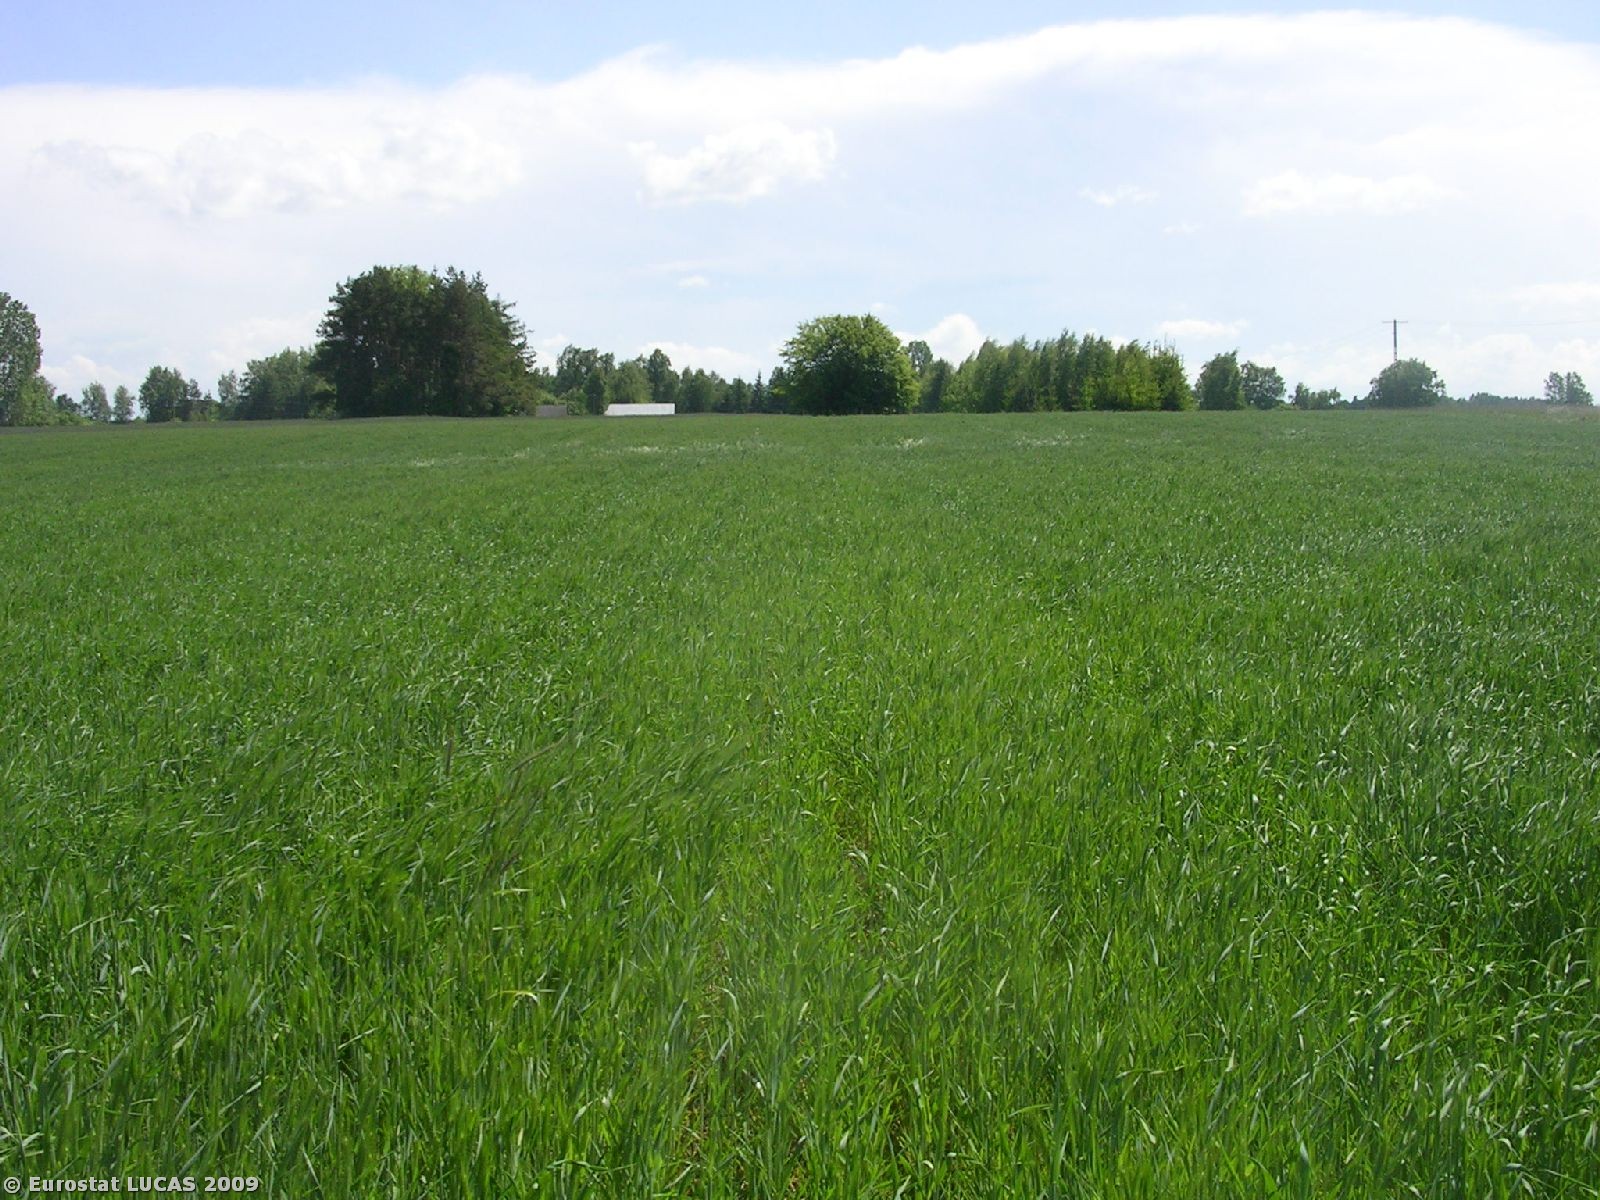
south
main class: Cropland
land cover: Barley
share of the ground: > 75 %
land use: Agriculture (excluding fallow land and kitchen gardens)
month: May
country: PL
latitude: 53.5522
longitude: 23.3482
